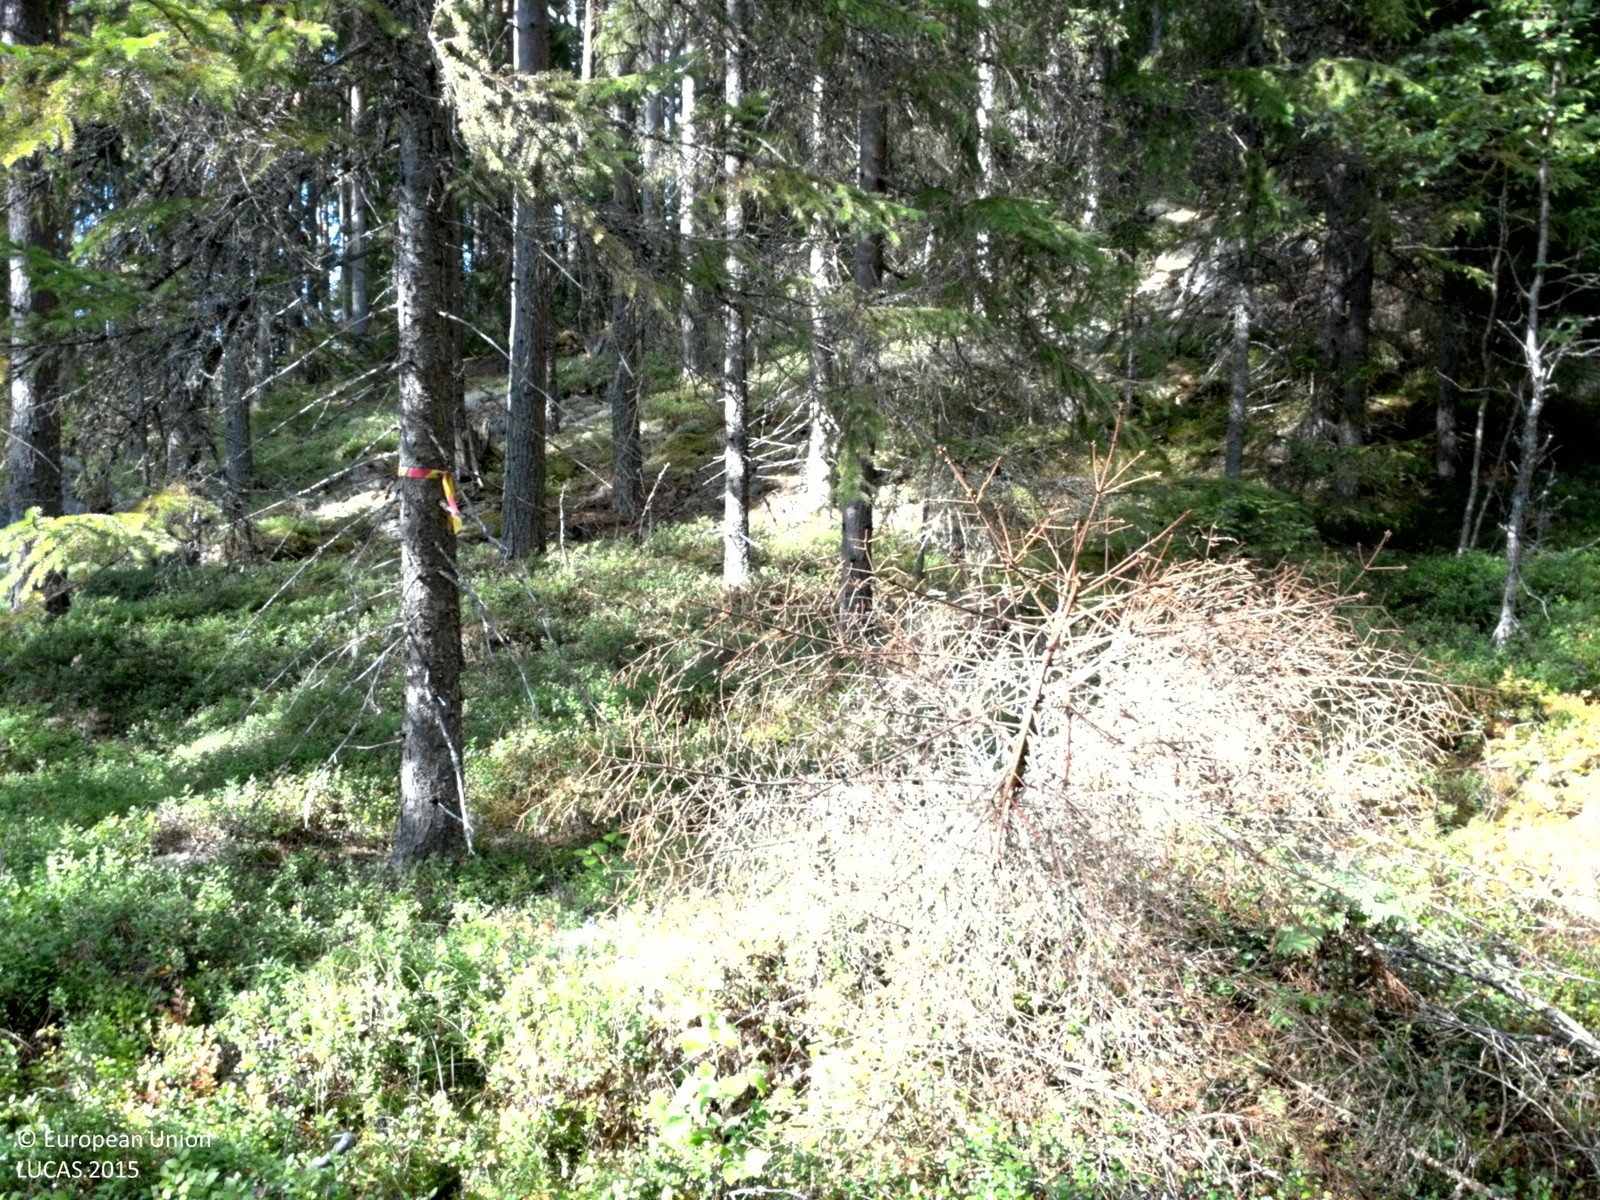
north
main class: Woodland
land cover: Other mixed woodland
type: boreal forest
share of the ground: > 75 %
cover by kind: coniferous forest trees 45 %, broadleaved forest trees 35 %, shrubs 10 %, herbaceous plants 5 %, lichens and mosses 5 %
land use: Forestry
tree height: > 5 m
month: August
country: SE
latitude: 60.0627
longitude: 14.2472
